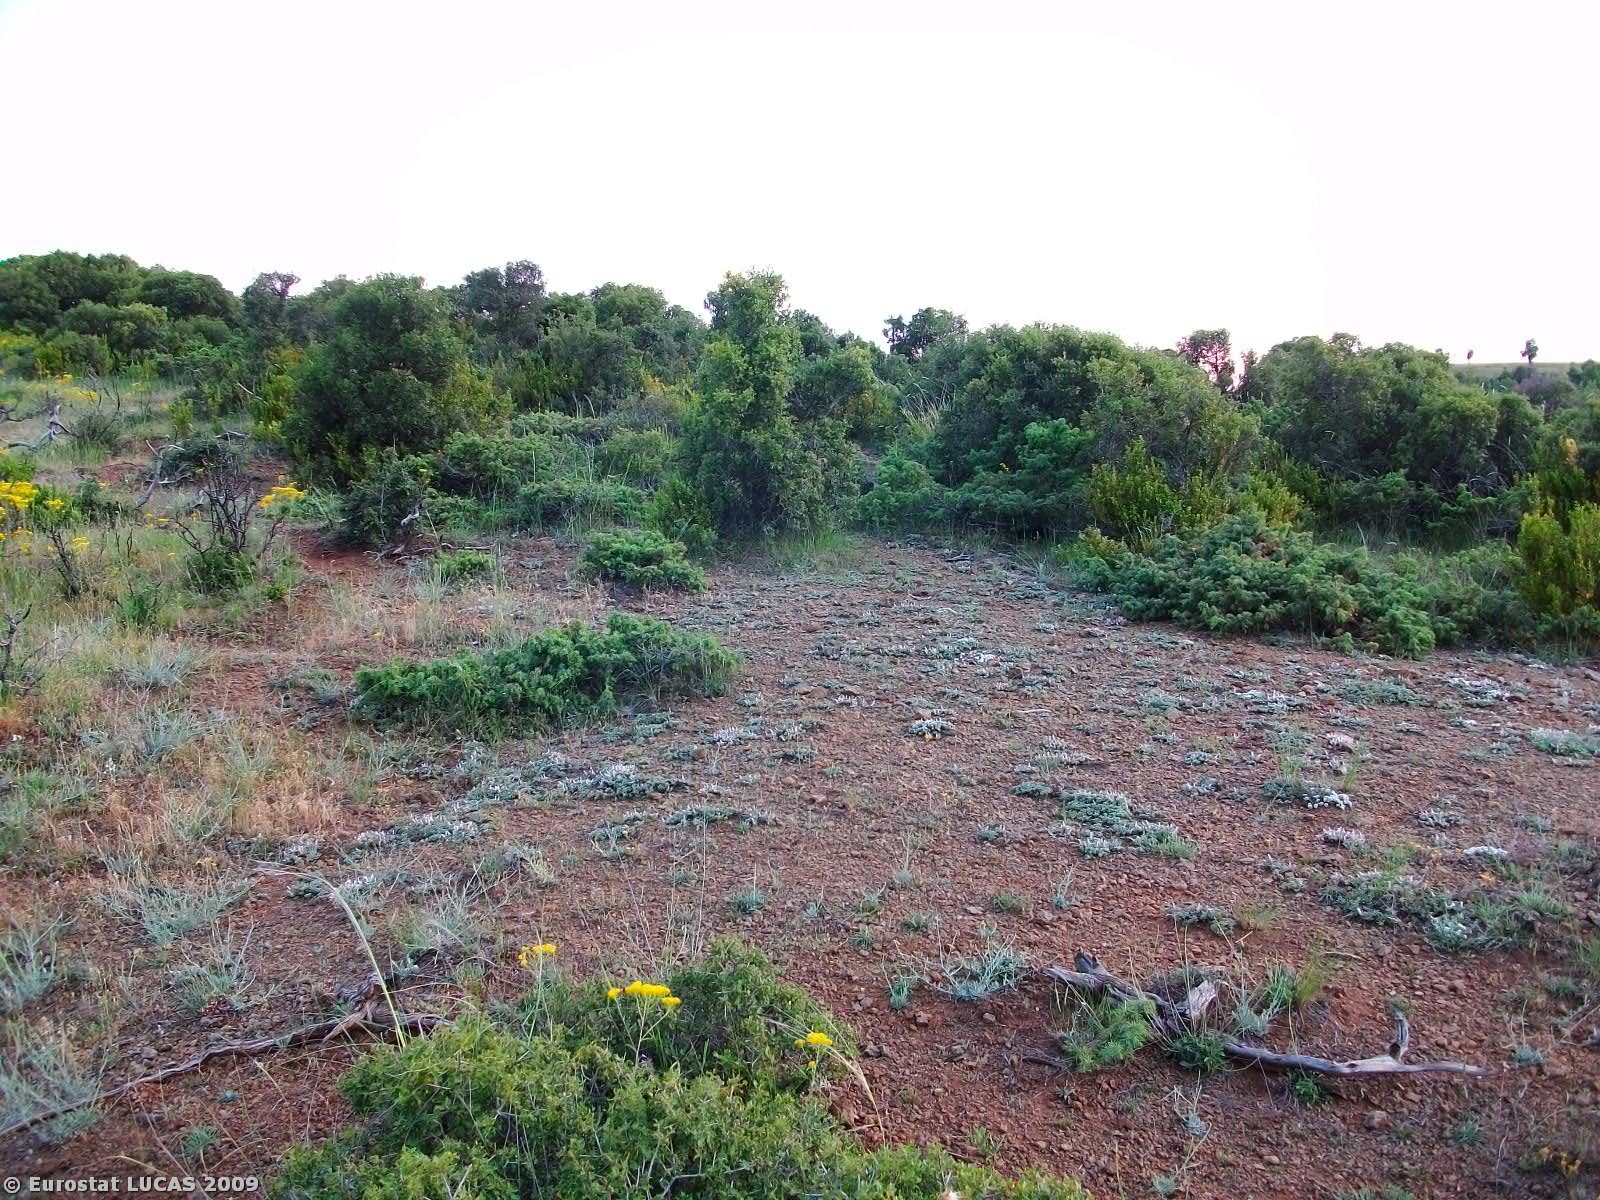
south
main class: Shrubland
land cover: Shrubland without tree cover
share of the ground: 25 - 50 %
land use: Agriculture (excluding fallow land and kitchen gardens)
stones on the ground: 25 - 50 %
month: June
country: GR
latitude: 40.0221
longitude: 21.6934
